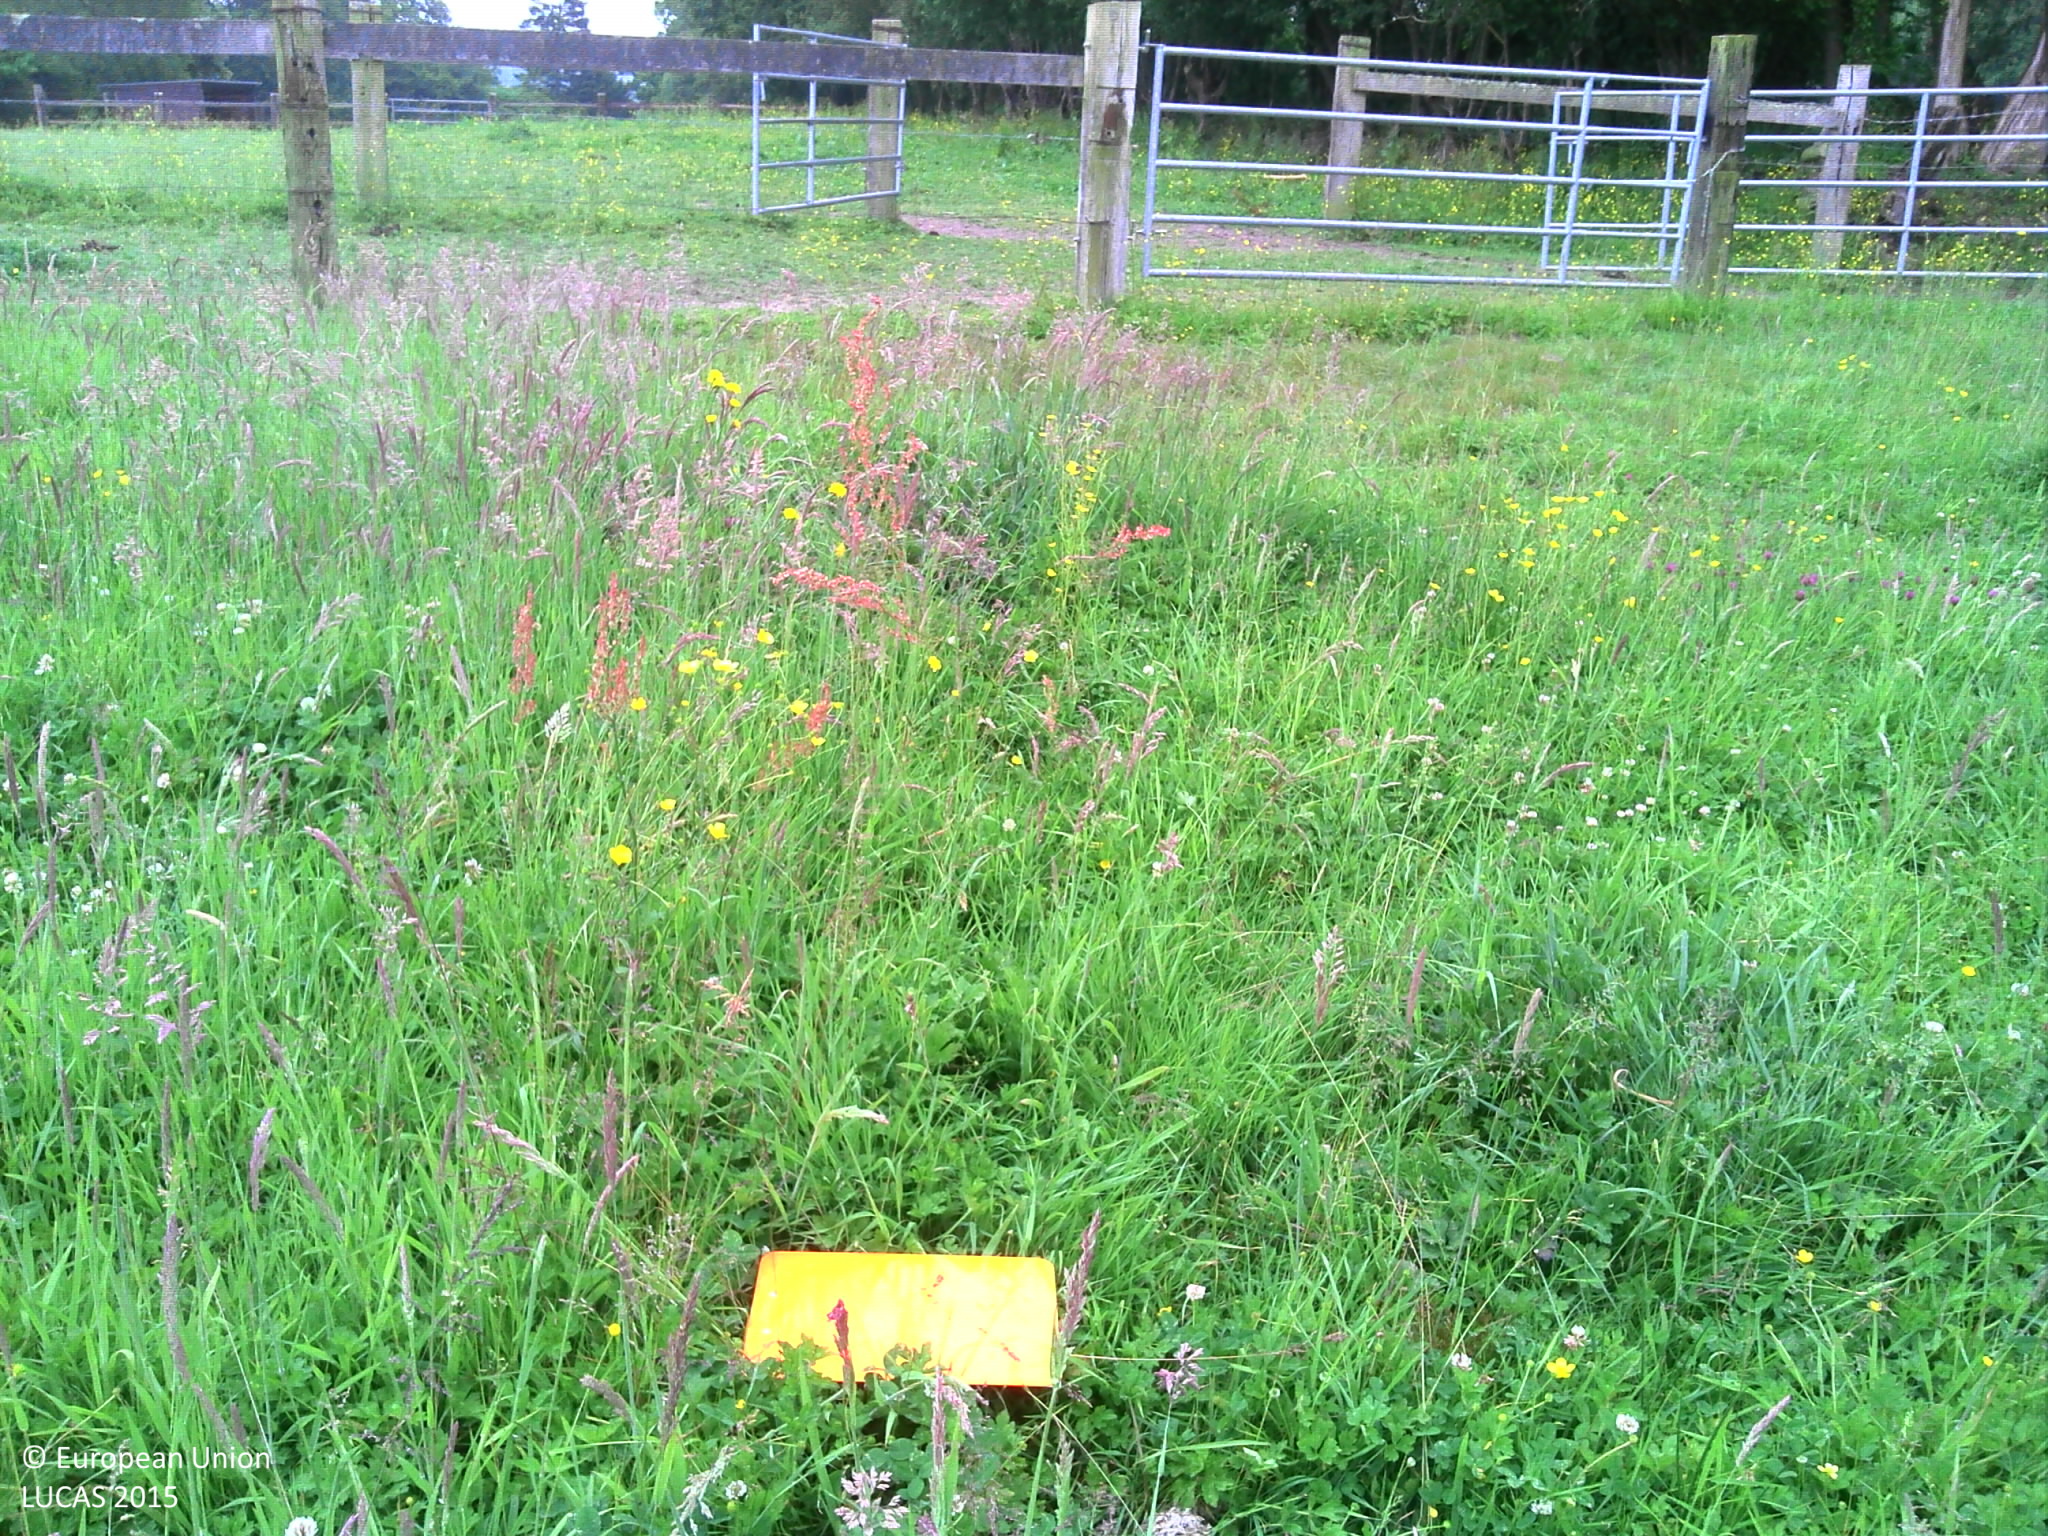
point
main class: Grassland
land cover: Grassland without tree/shrub cover
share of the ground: > 75 %
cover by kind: herbaceous plants 100 %
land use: Agriculture (excluding fallow land and kitchen gardens)
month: June
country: FR
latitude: 49.2347
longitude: -0.0157
